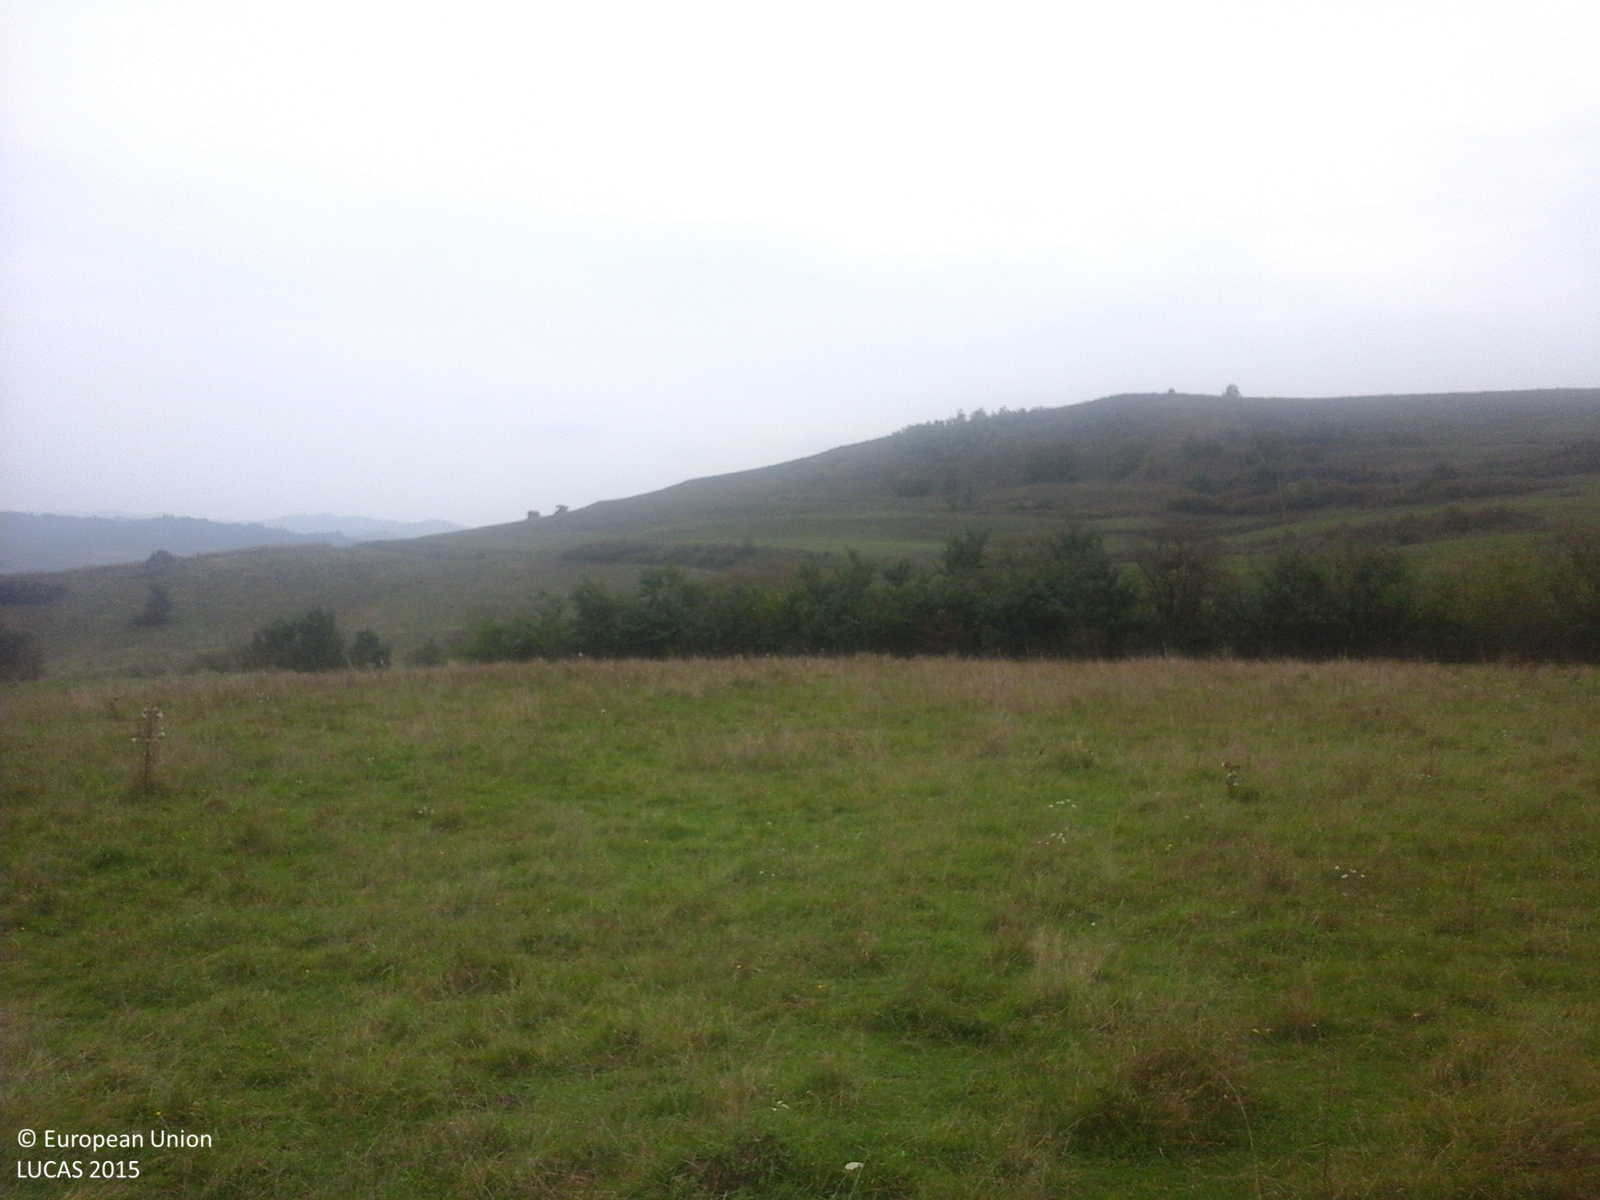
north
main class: Grassland
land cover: Grassland without tree/shrub cover
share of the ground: > 75 %
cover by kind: herbaceous plants 100 %
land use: Agriculture (excluding fallow land and kitchen gardens)
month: October
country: RO
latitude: 46.2317
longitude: 24.9145
